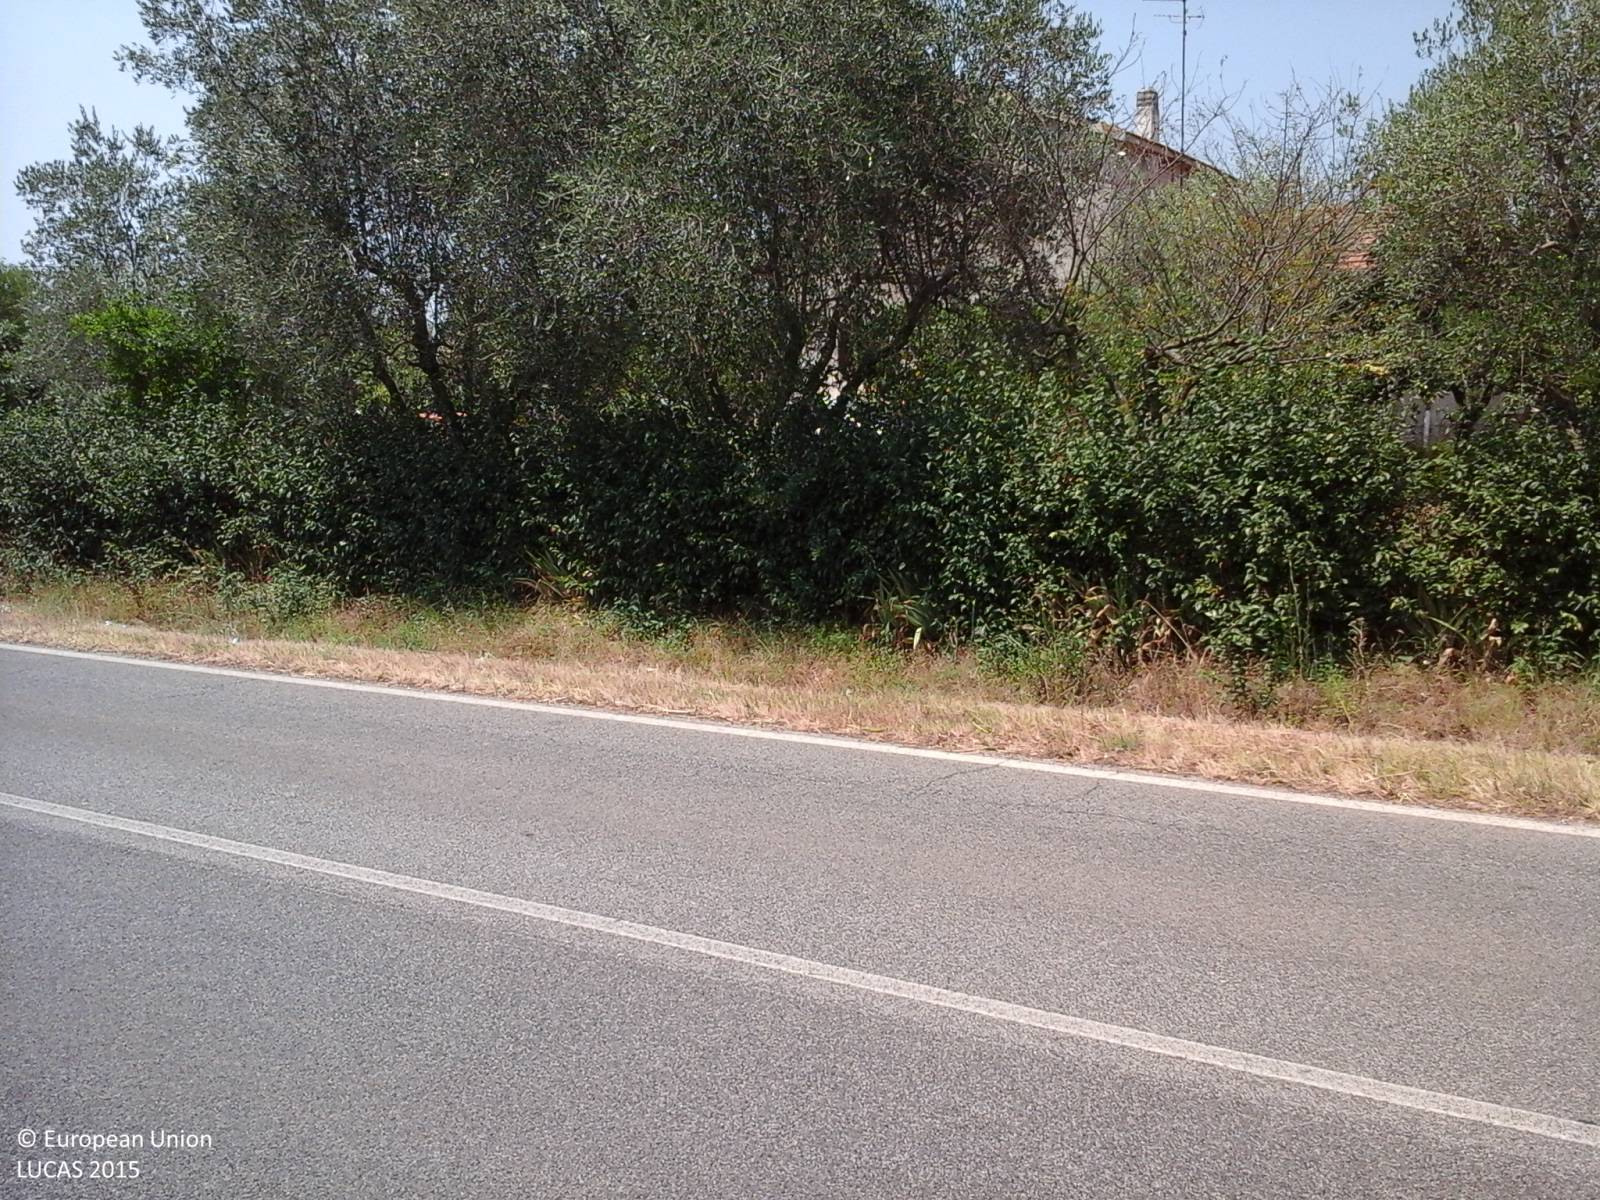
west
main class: Cropland
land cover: Temporary grasslands
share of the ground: > 75 %
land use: Agriculture (excluding fallow land and kitchen gardens)
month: July
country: IT
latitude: 42.0327
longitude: 12.2505
